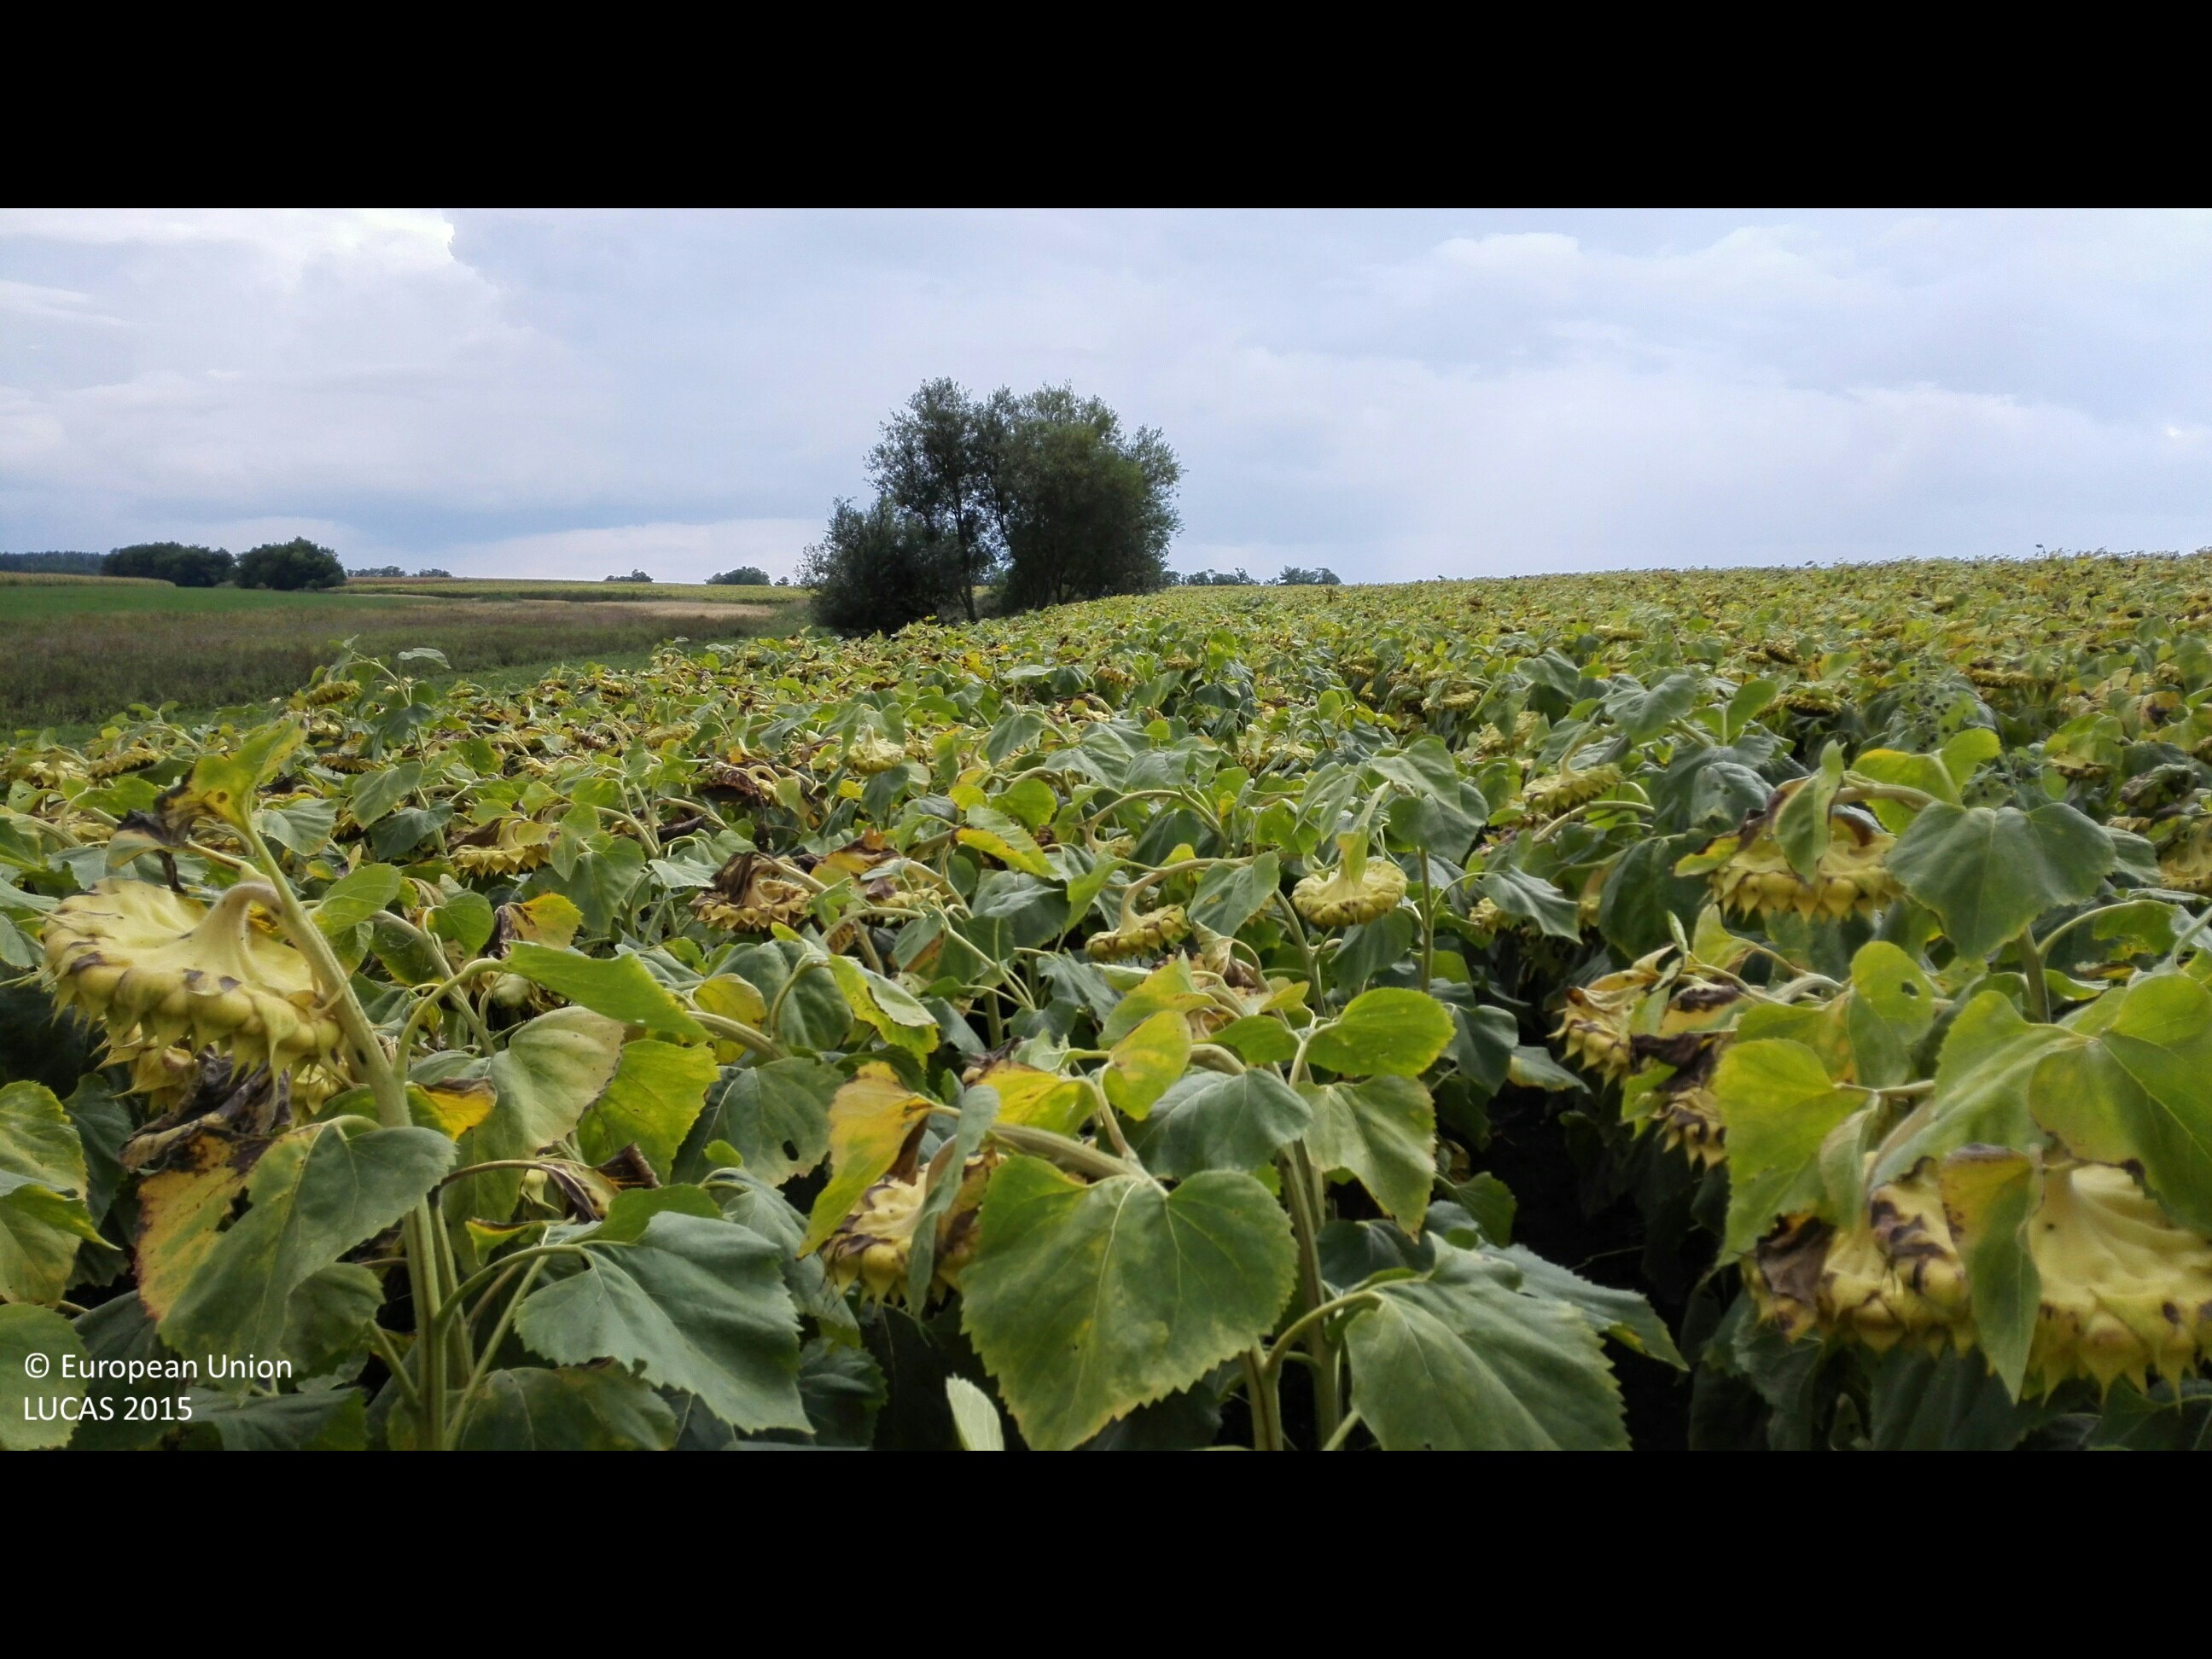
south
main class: Cropland
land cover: Sunflower
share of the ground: > 75 %
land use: Agriculture (excluding fallow land and kitchen gardens)
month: August
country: HU
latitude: 47.3160
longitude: 21.6190
